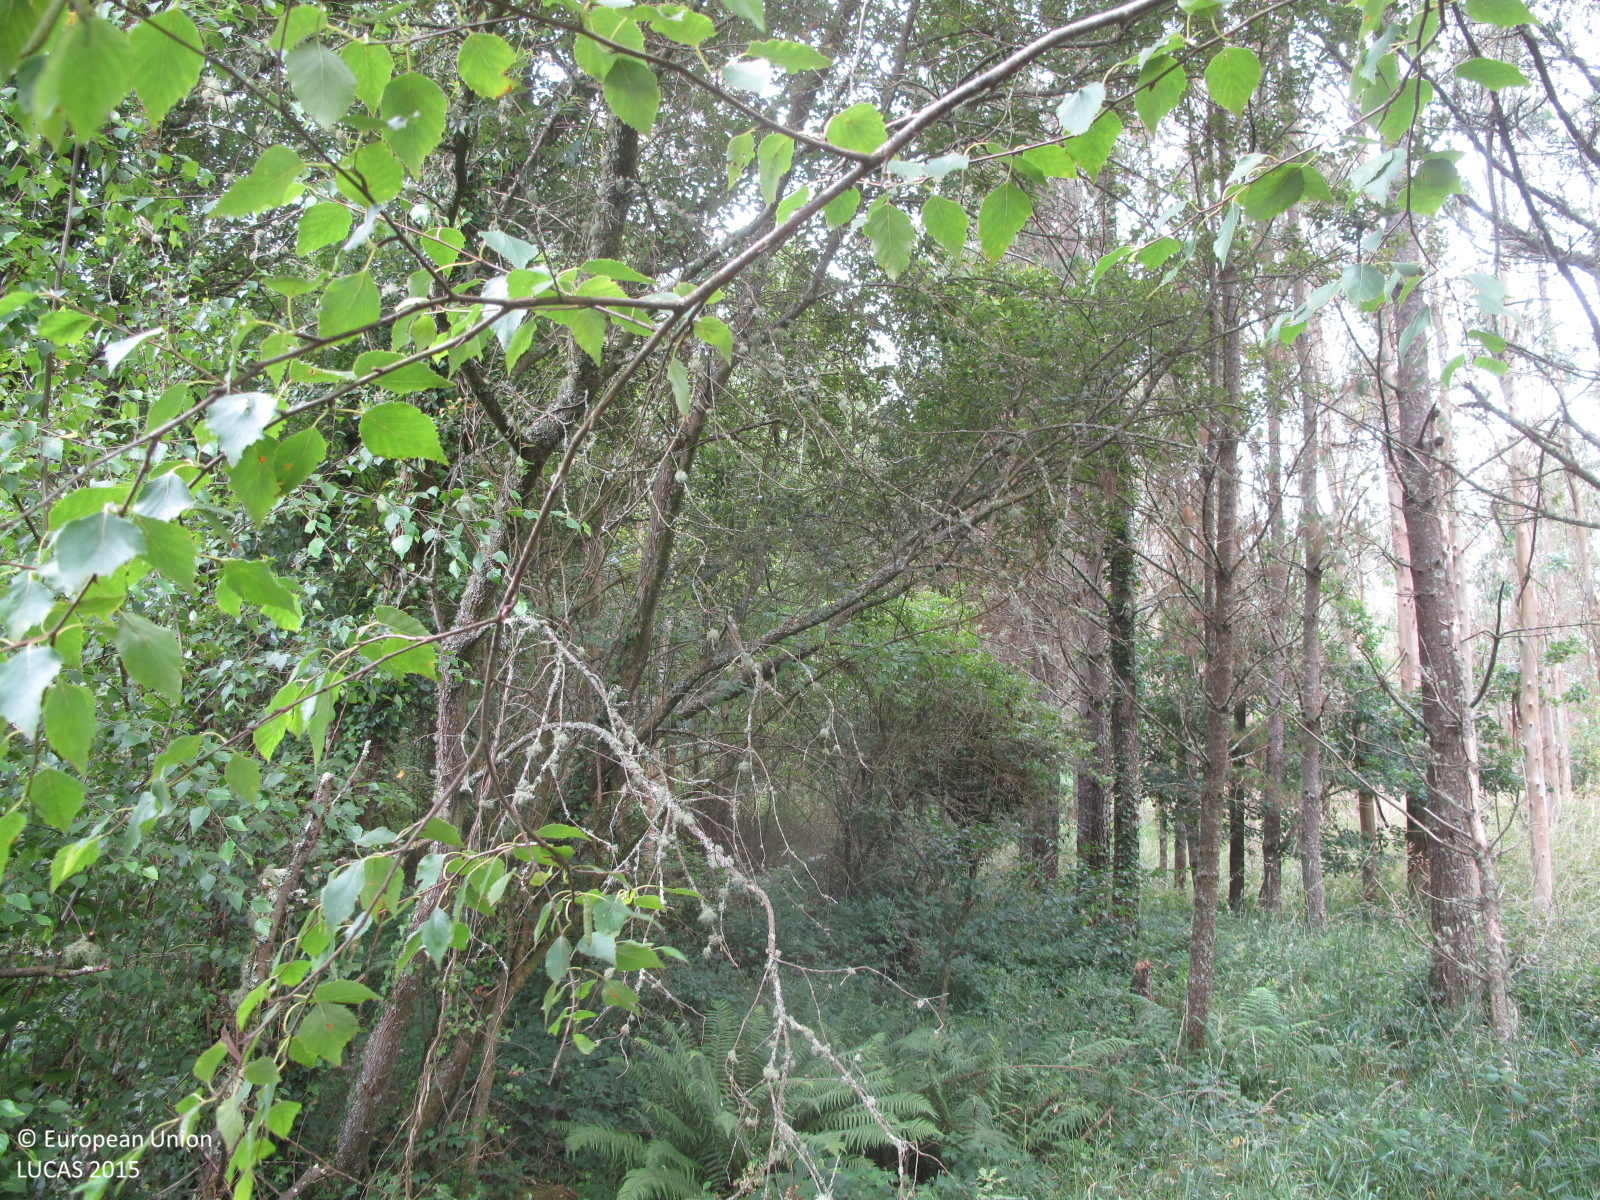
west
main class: Woodland
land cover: Broadleaved woodland
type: acidophilous oak and oak-birch forest
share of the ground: > 75 %
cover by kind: broadleaved forest trees 80 %, shrubs 10 %, herbaceous plants 10 %
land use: Semi-natural and natural areas not in use
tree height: > 5 m
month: July
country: ES
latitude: 43.4303
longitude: -8.0714
